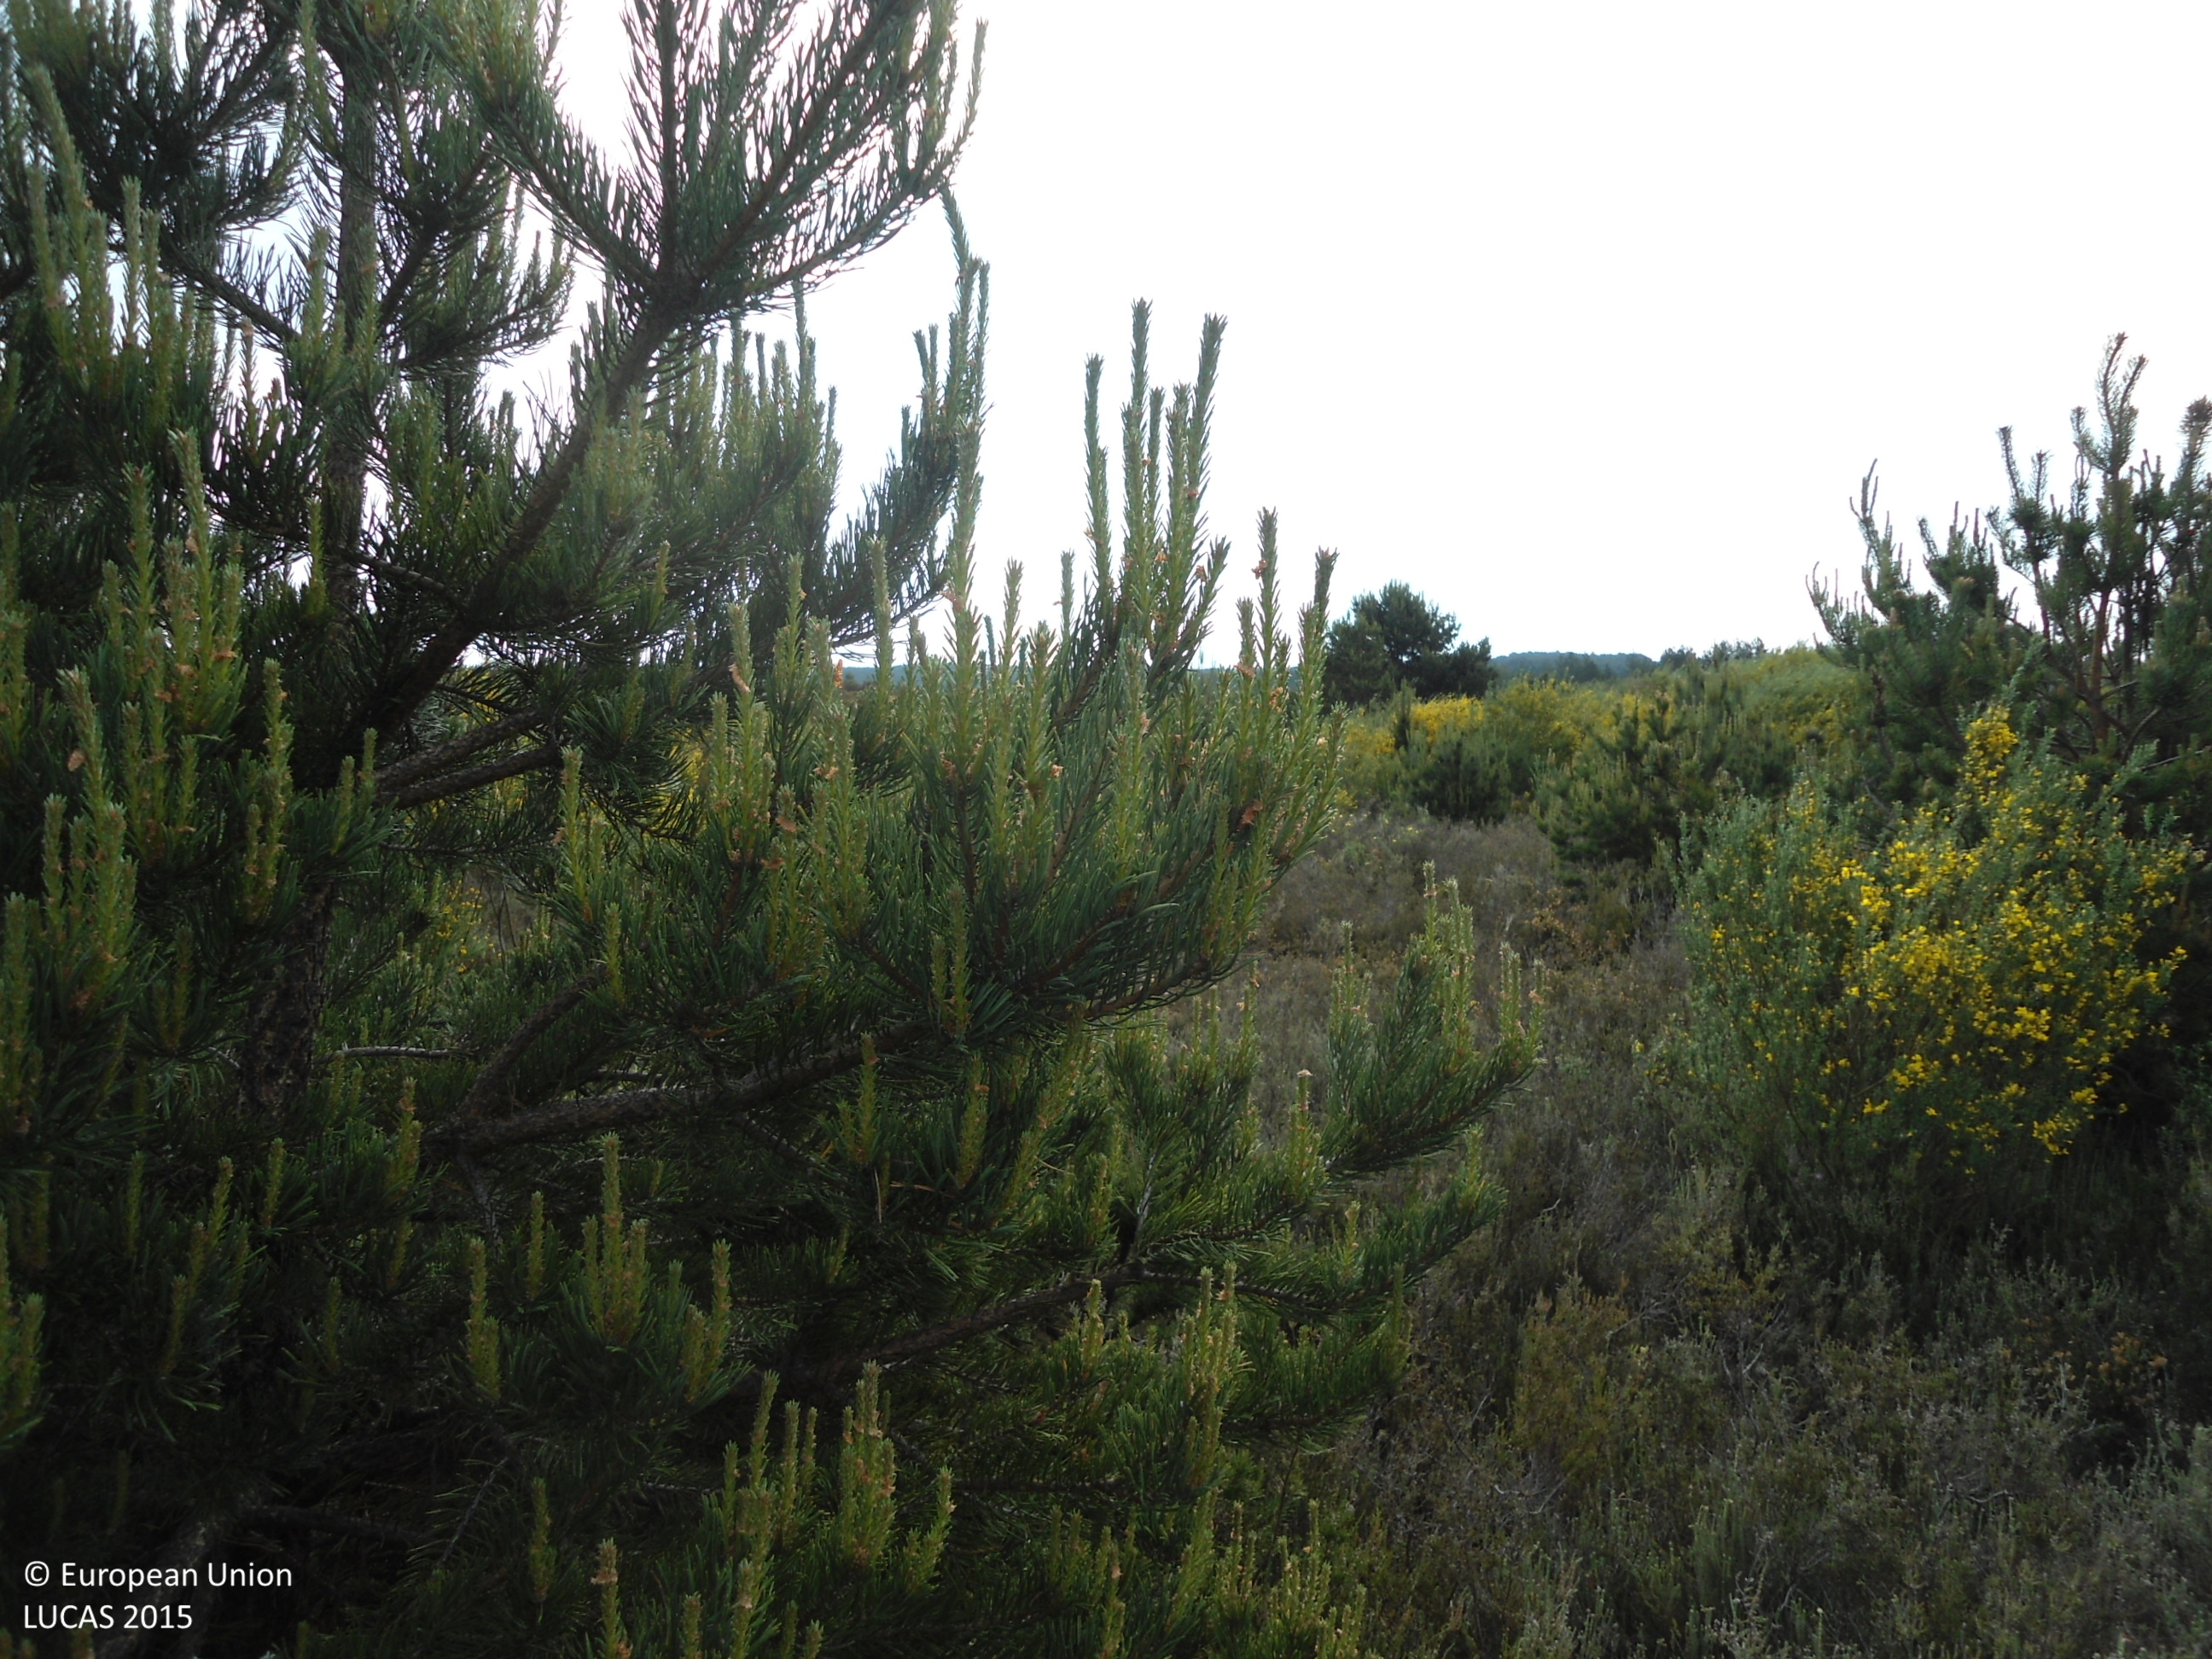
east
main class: Woodland
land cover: Pine dominated coniferous woodland
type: coniferous forest of the mediterranean region
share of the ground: 25 - 50 %
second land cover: Shrubland without tree cover
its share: 50 - 75 %
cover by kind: shrubs 70 %, coniferous forest trees 25 %, herbaceous plants 5 %
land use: Forestry
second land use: Community services
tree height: < 5 m
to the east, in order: Pine dominated coniferous woodland; Shrubland without tree cover; Rivers and streams; Shrubland with sparse tree cover; Pine dominated coniferous woodland; Other bare soil; Tracks; Other bare soil; Shrubland with sparse tree cover; Pine dominated coniferous woodland
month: June
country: ES
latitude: 41.9827
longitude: -6.5371
